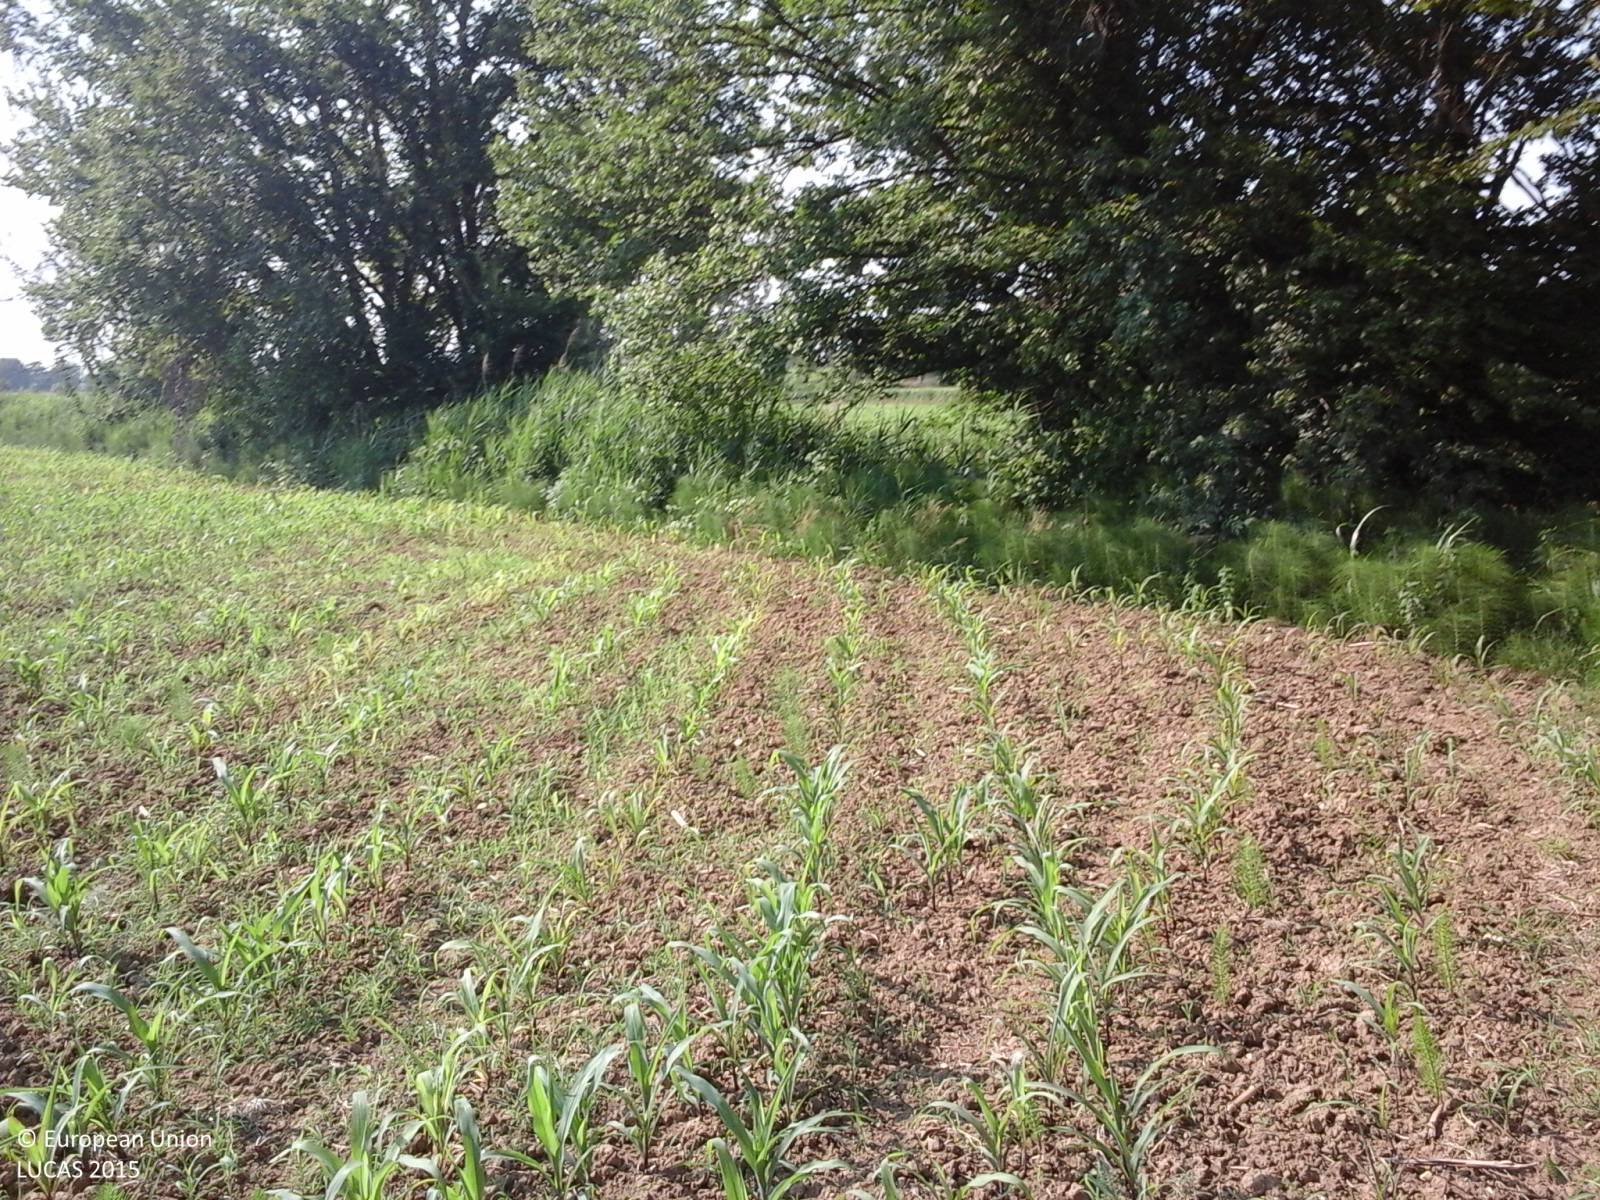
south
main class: Cropland
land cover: Maize
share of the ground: < 10 %
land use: Agriculture (excluding fallow land and kitchen gardens)
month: June
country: IT
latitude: 45.9625
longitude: 12.4614
